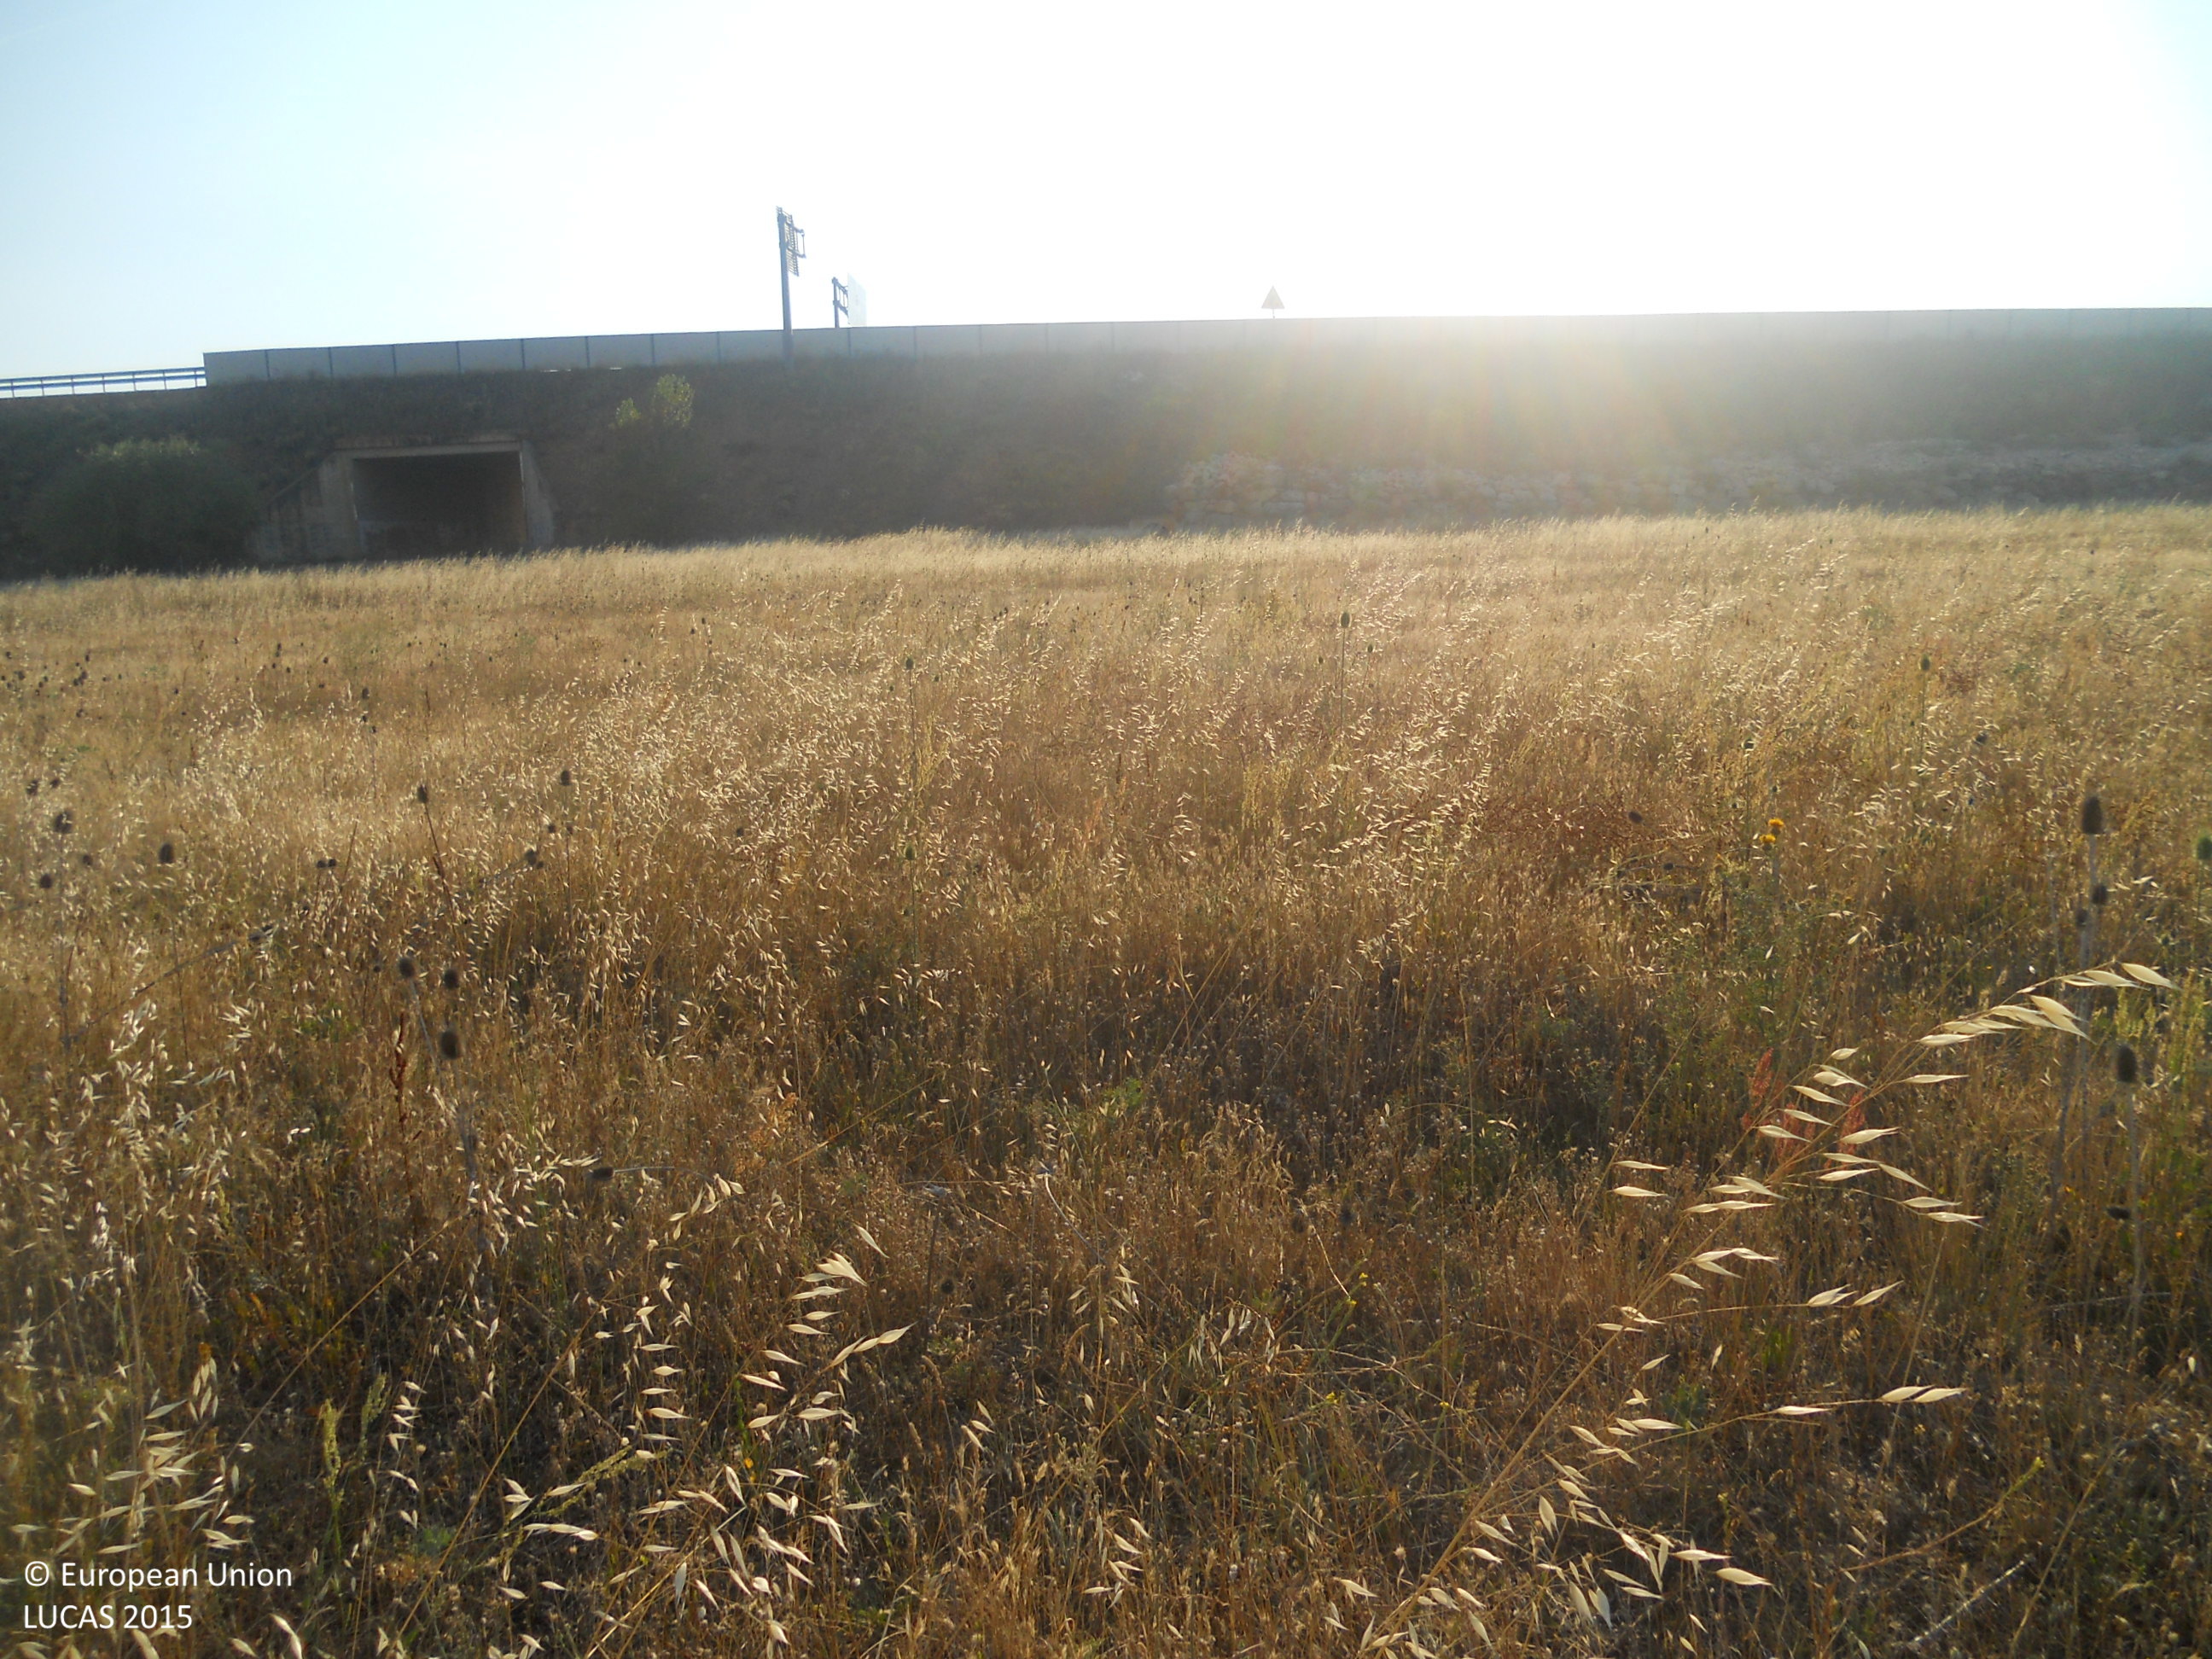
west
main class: Grassland
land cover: Grassland without tree/shrub cover
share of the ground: > 75 %
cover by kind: herbaceous plants 100 %
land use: Agriculture (excluding fallow land and kitchen gardens)
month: July
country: ES
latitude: 42.5209
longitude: -5.5923
